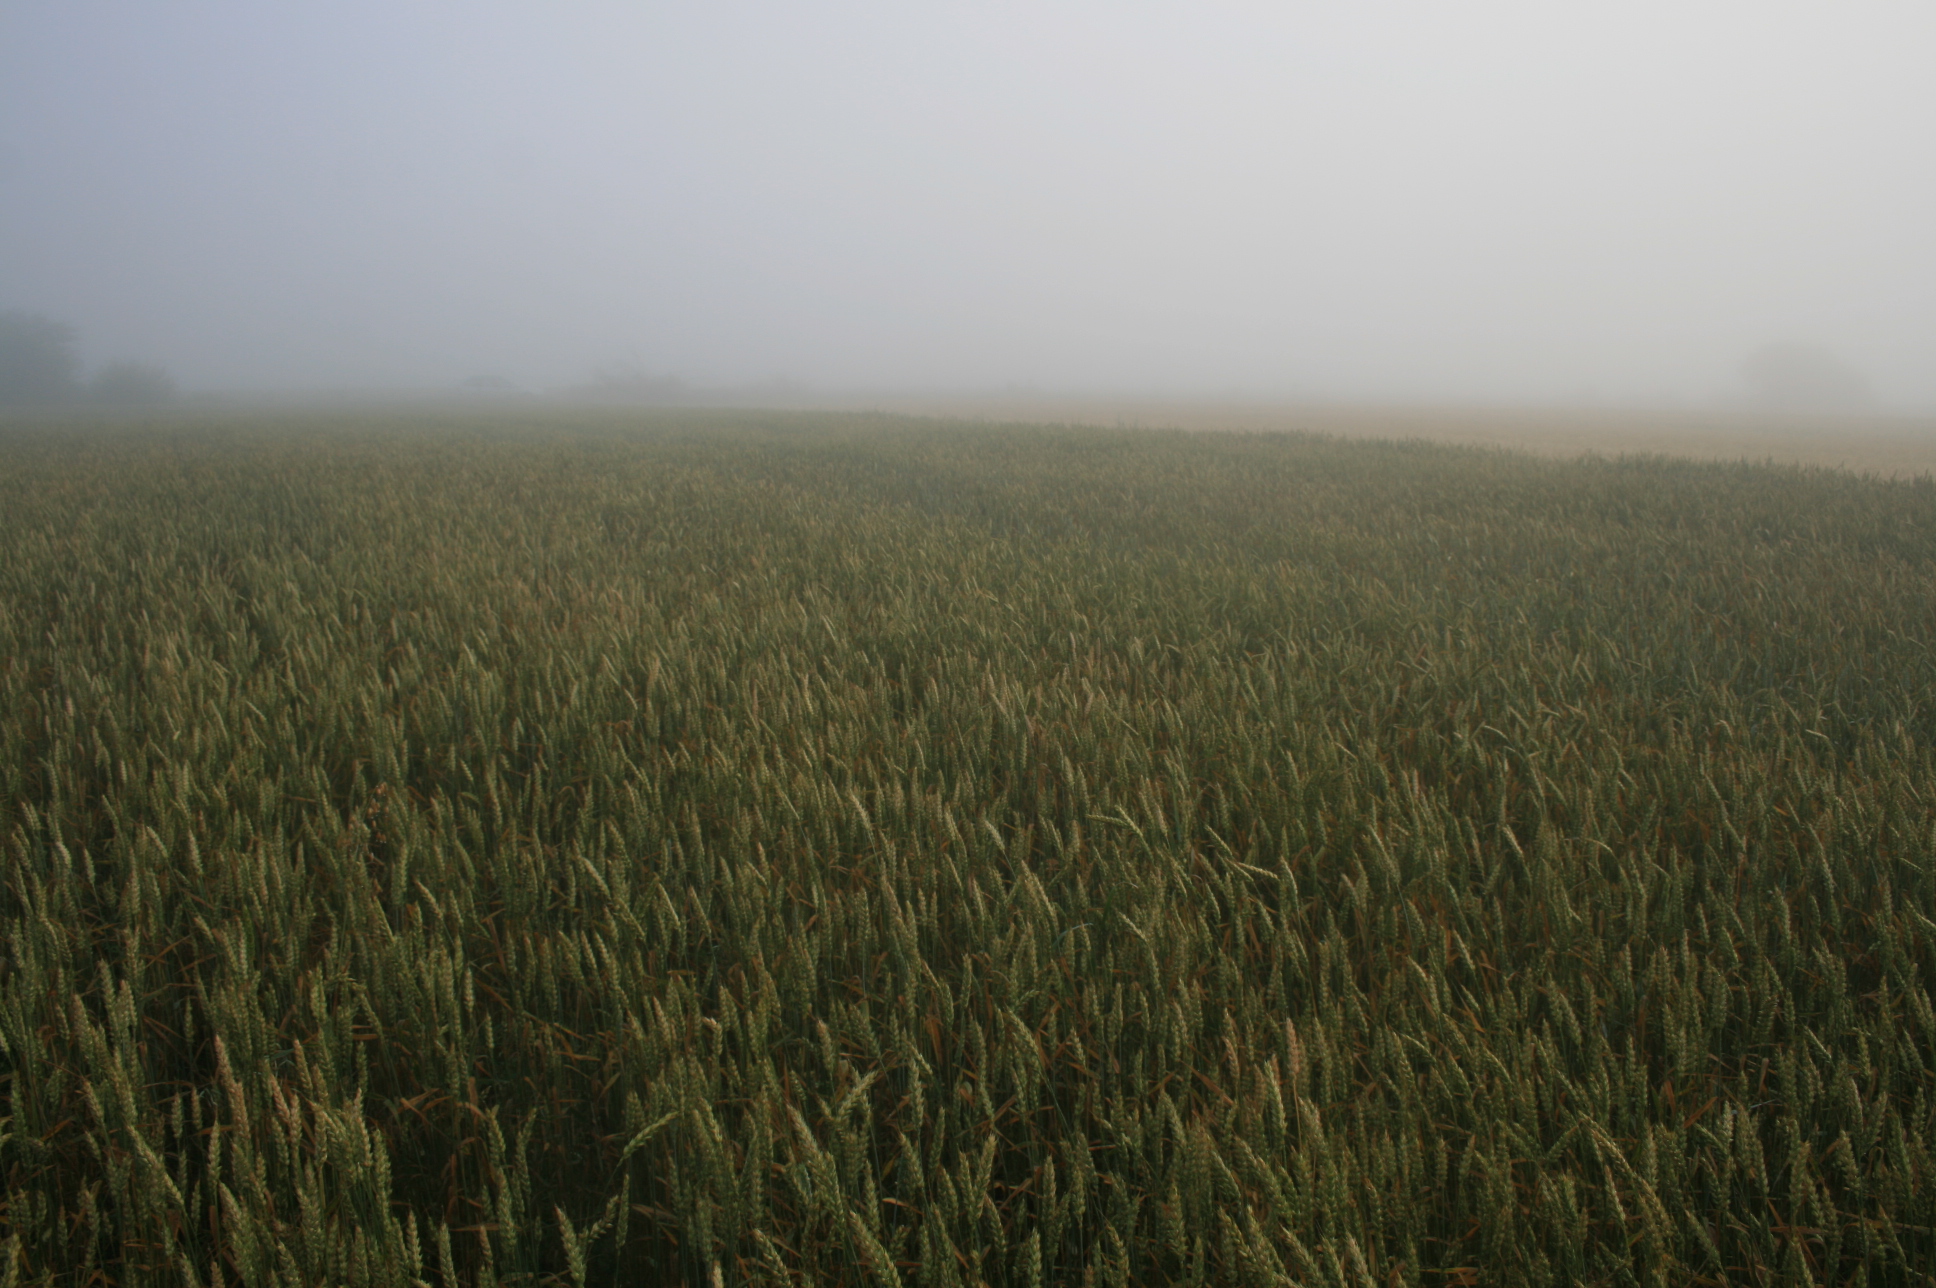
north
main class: Cropland
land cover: Common wheat
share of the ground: > 75 %
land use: Agriculture (excluding fallow land and kitchen gardens)
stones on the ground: < 10 %
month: August
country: LT
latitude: 55.6674
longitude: 21.3146
